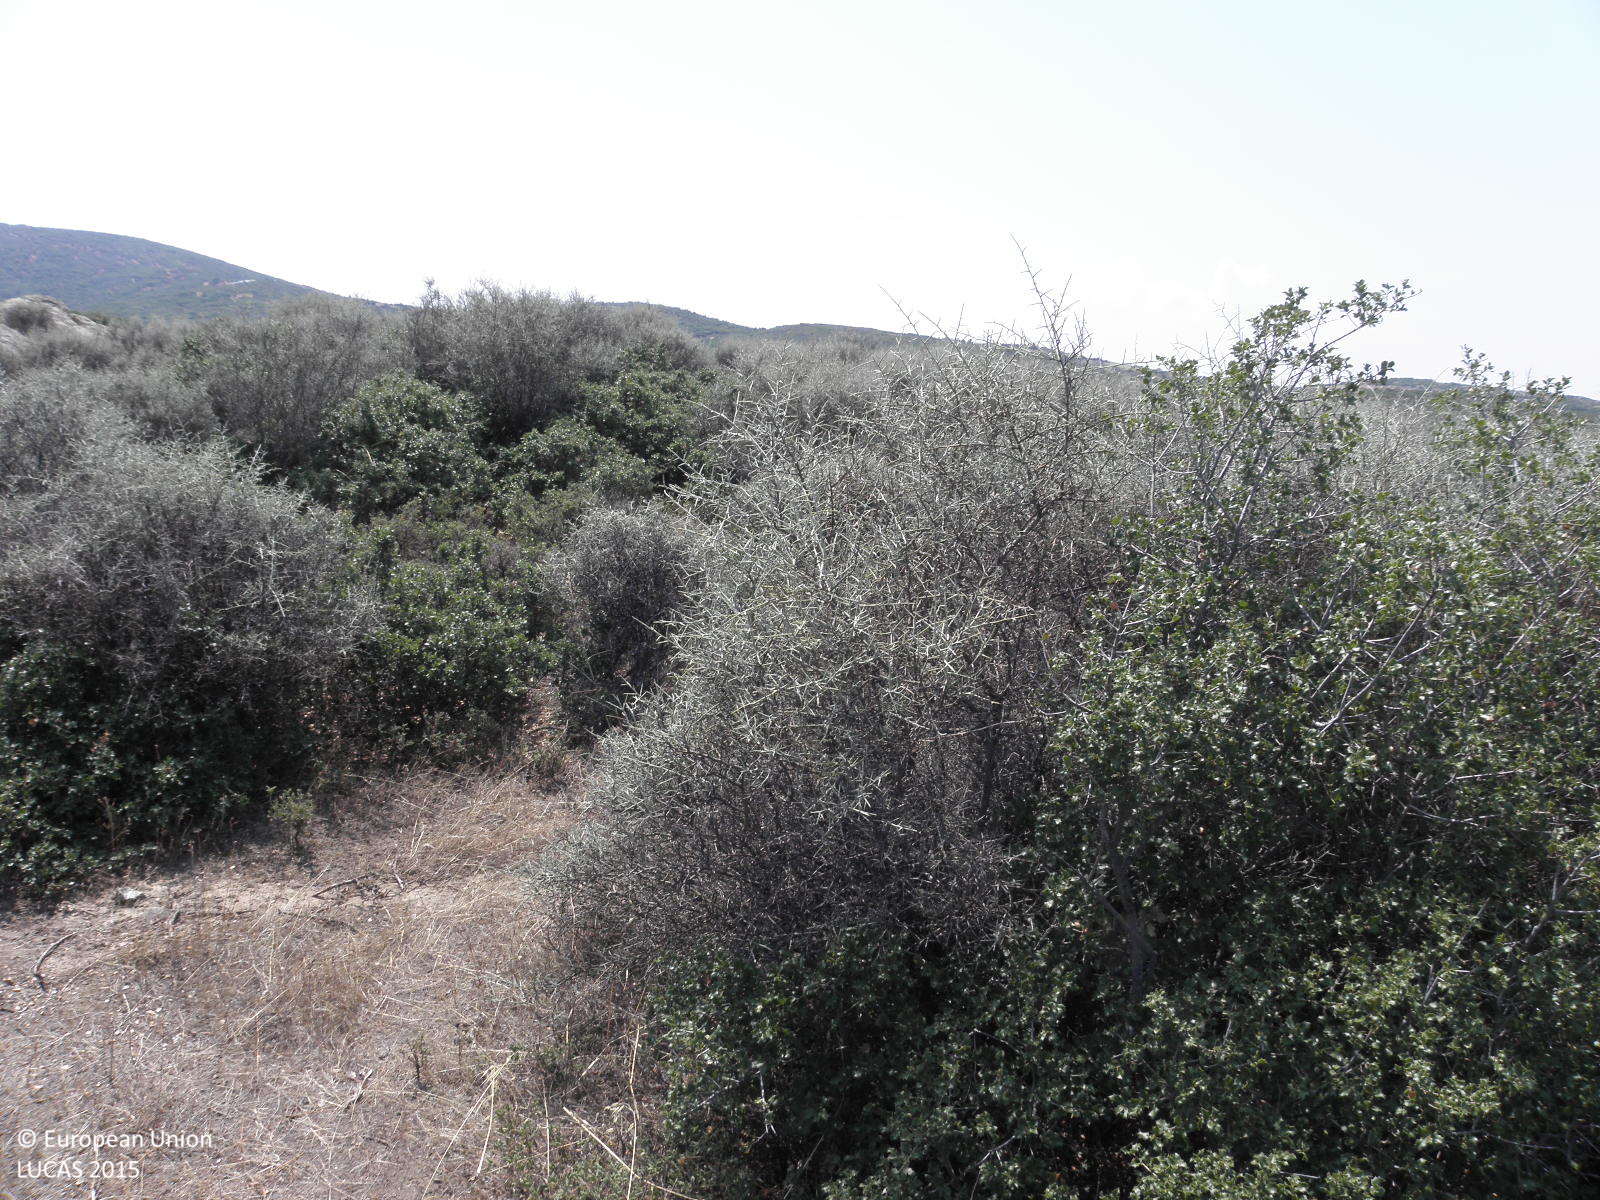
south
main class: Shrubland
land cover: Shrubland without tree cover
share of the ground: > 75 %
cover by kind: shrubs 90 %, herbaceous plants 10 %
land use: Agriculture (excluding fallow land and kitchen gardens)
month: August
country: GR
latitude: 39.6181
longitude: 22.7245
